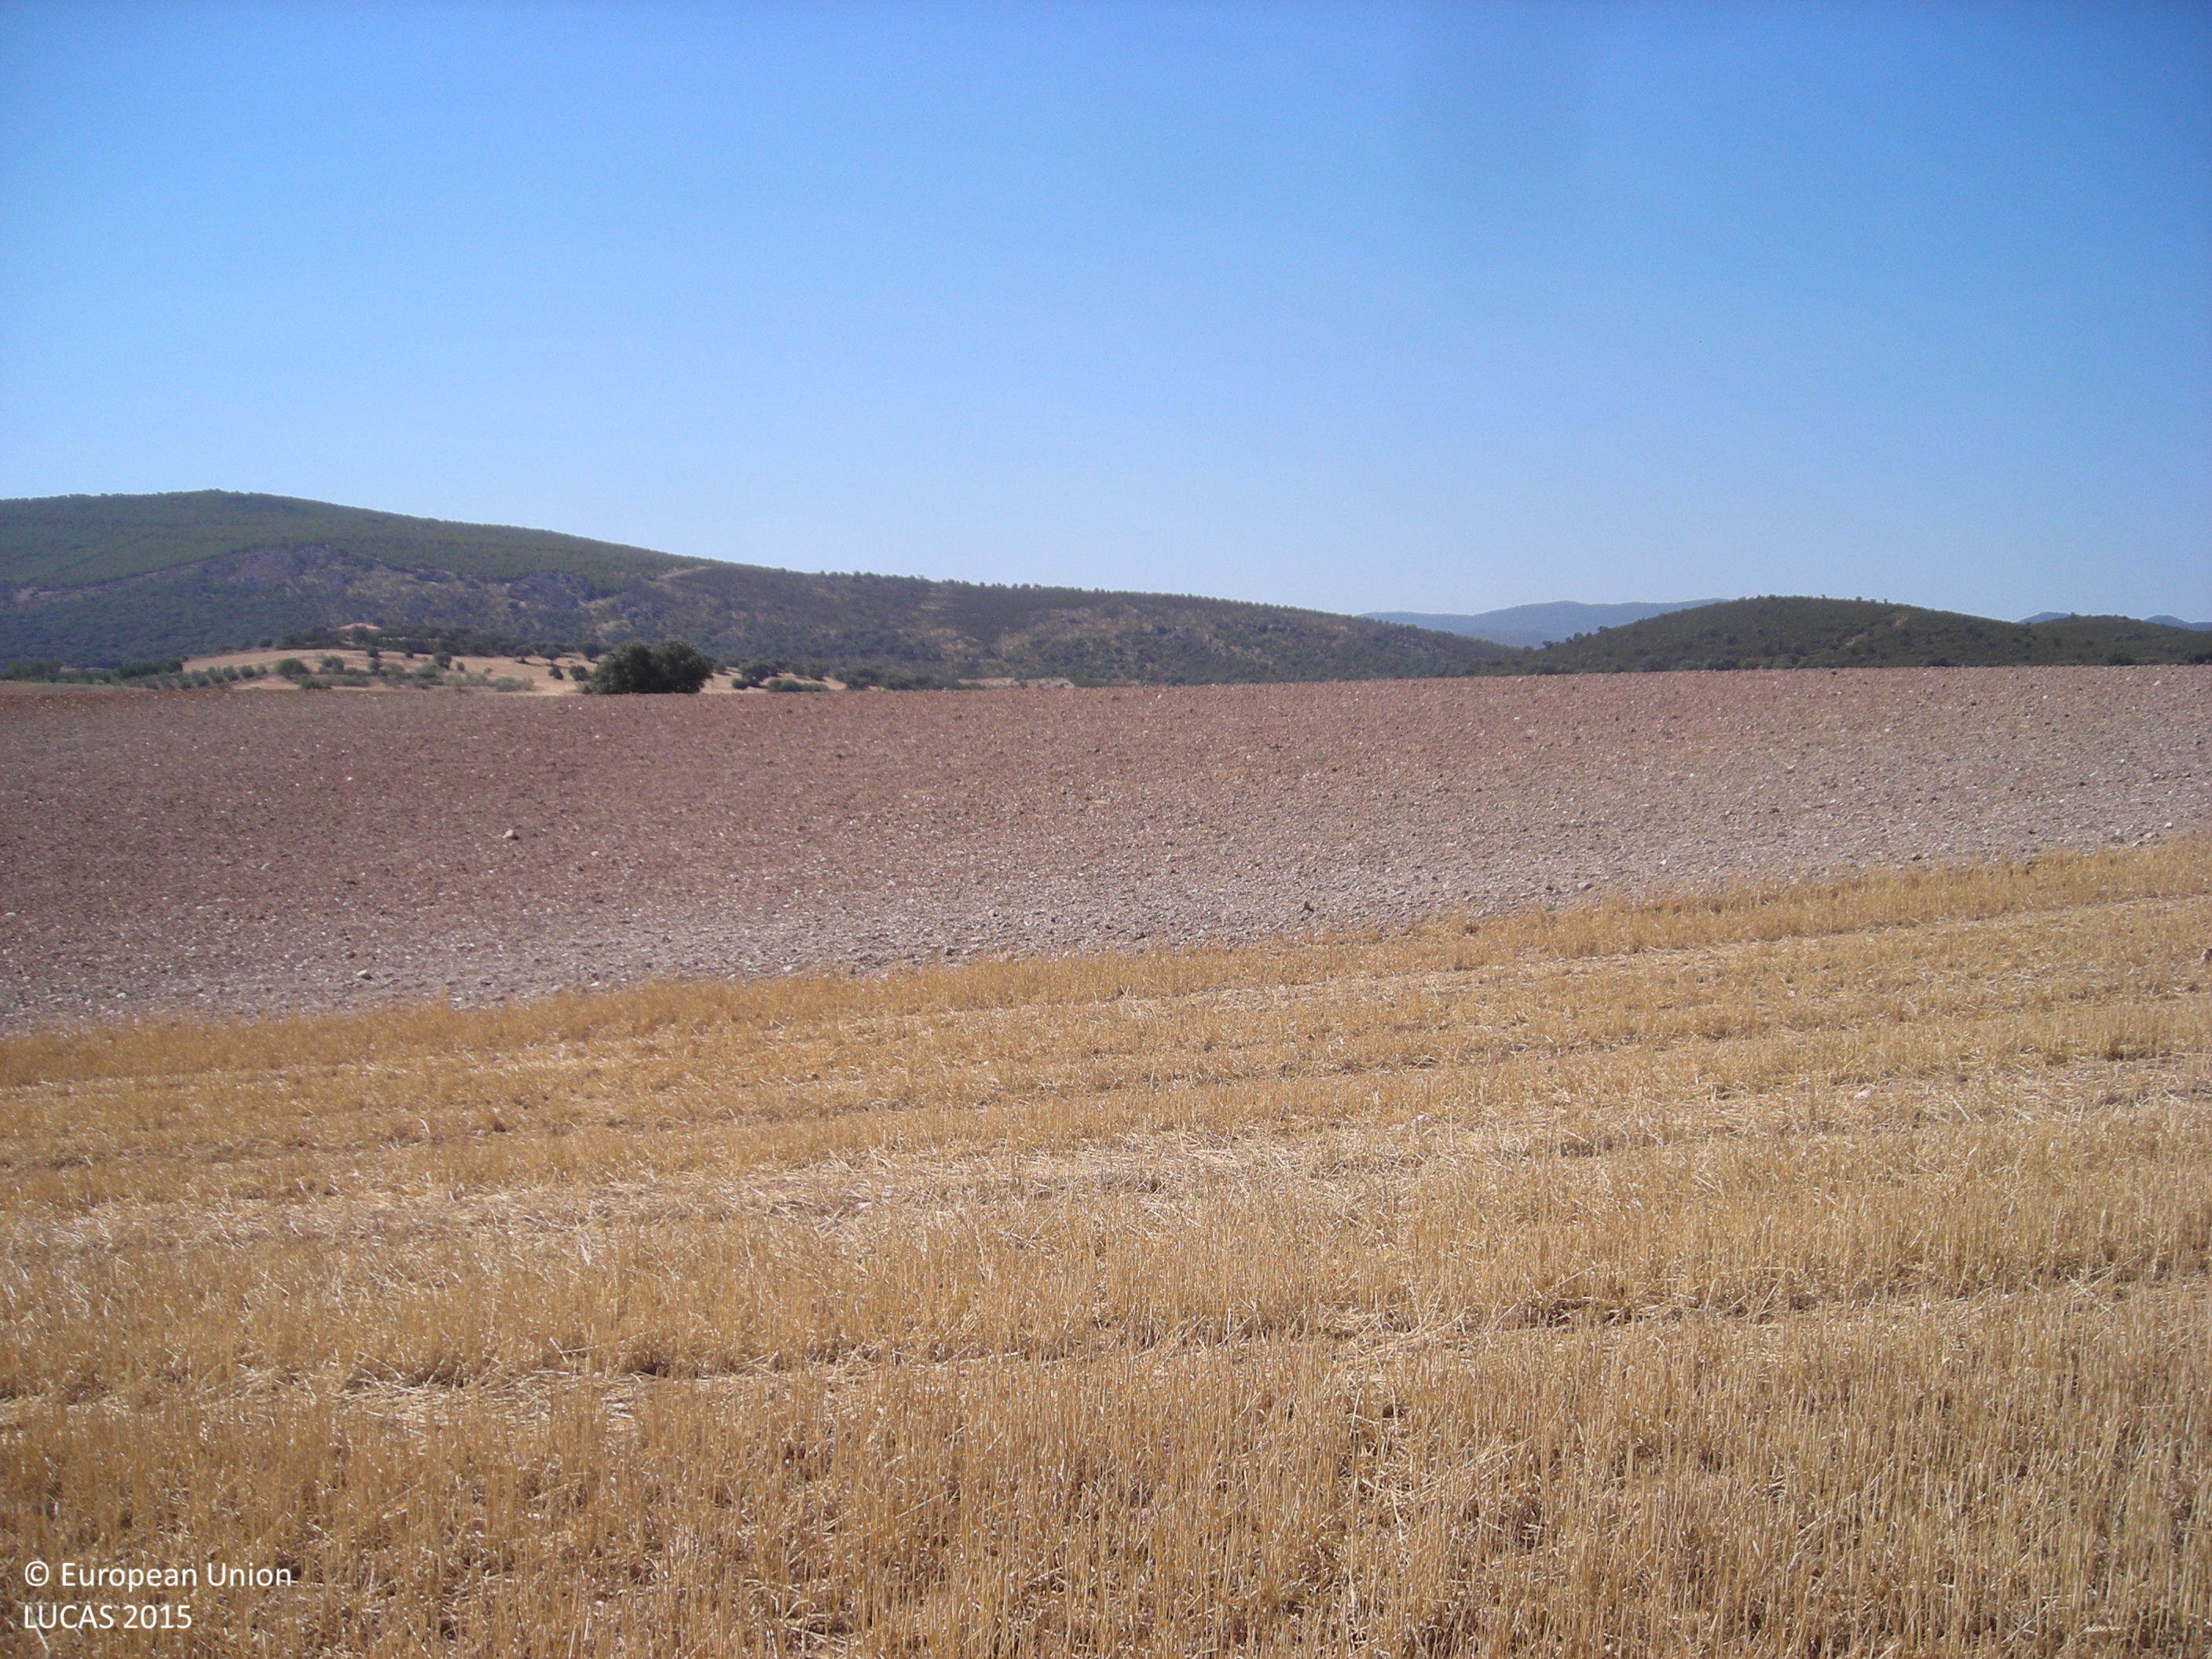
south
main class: Cropland
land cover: Common wheat
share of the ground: > 75 %
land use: Agriculture (excluding fallow land and kitchen gardens)
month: July
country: ES
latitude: 38.8308
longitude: -5.9102
